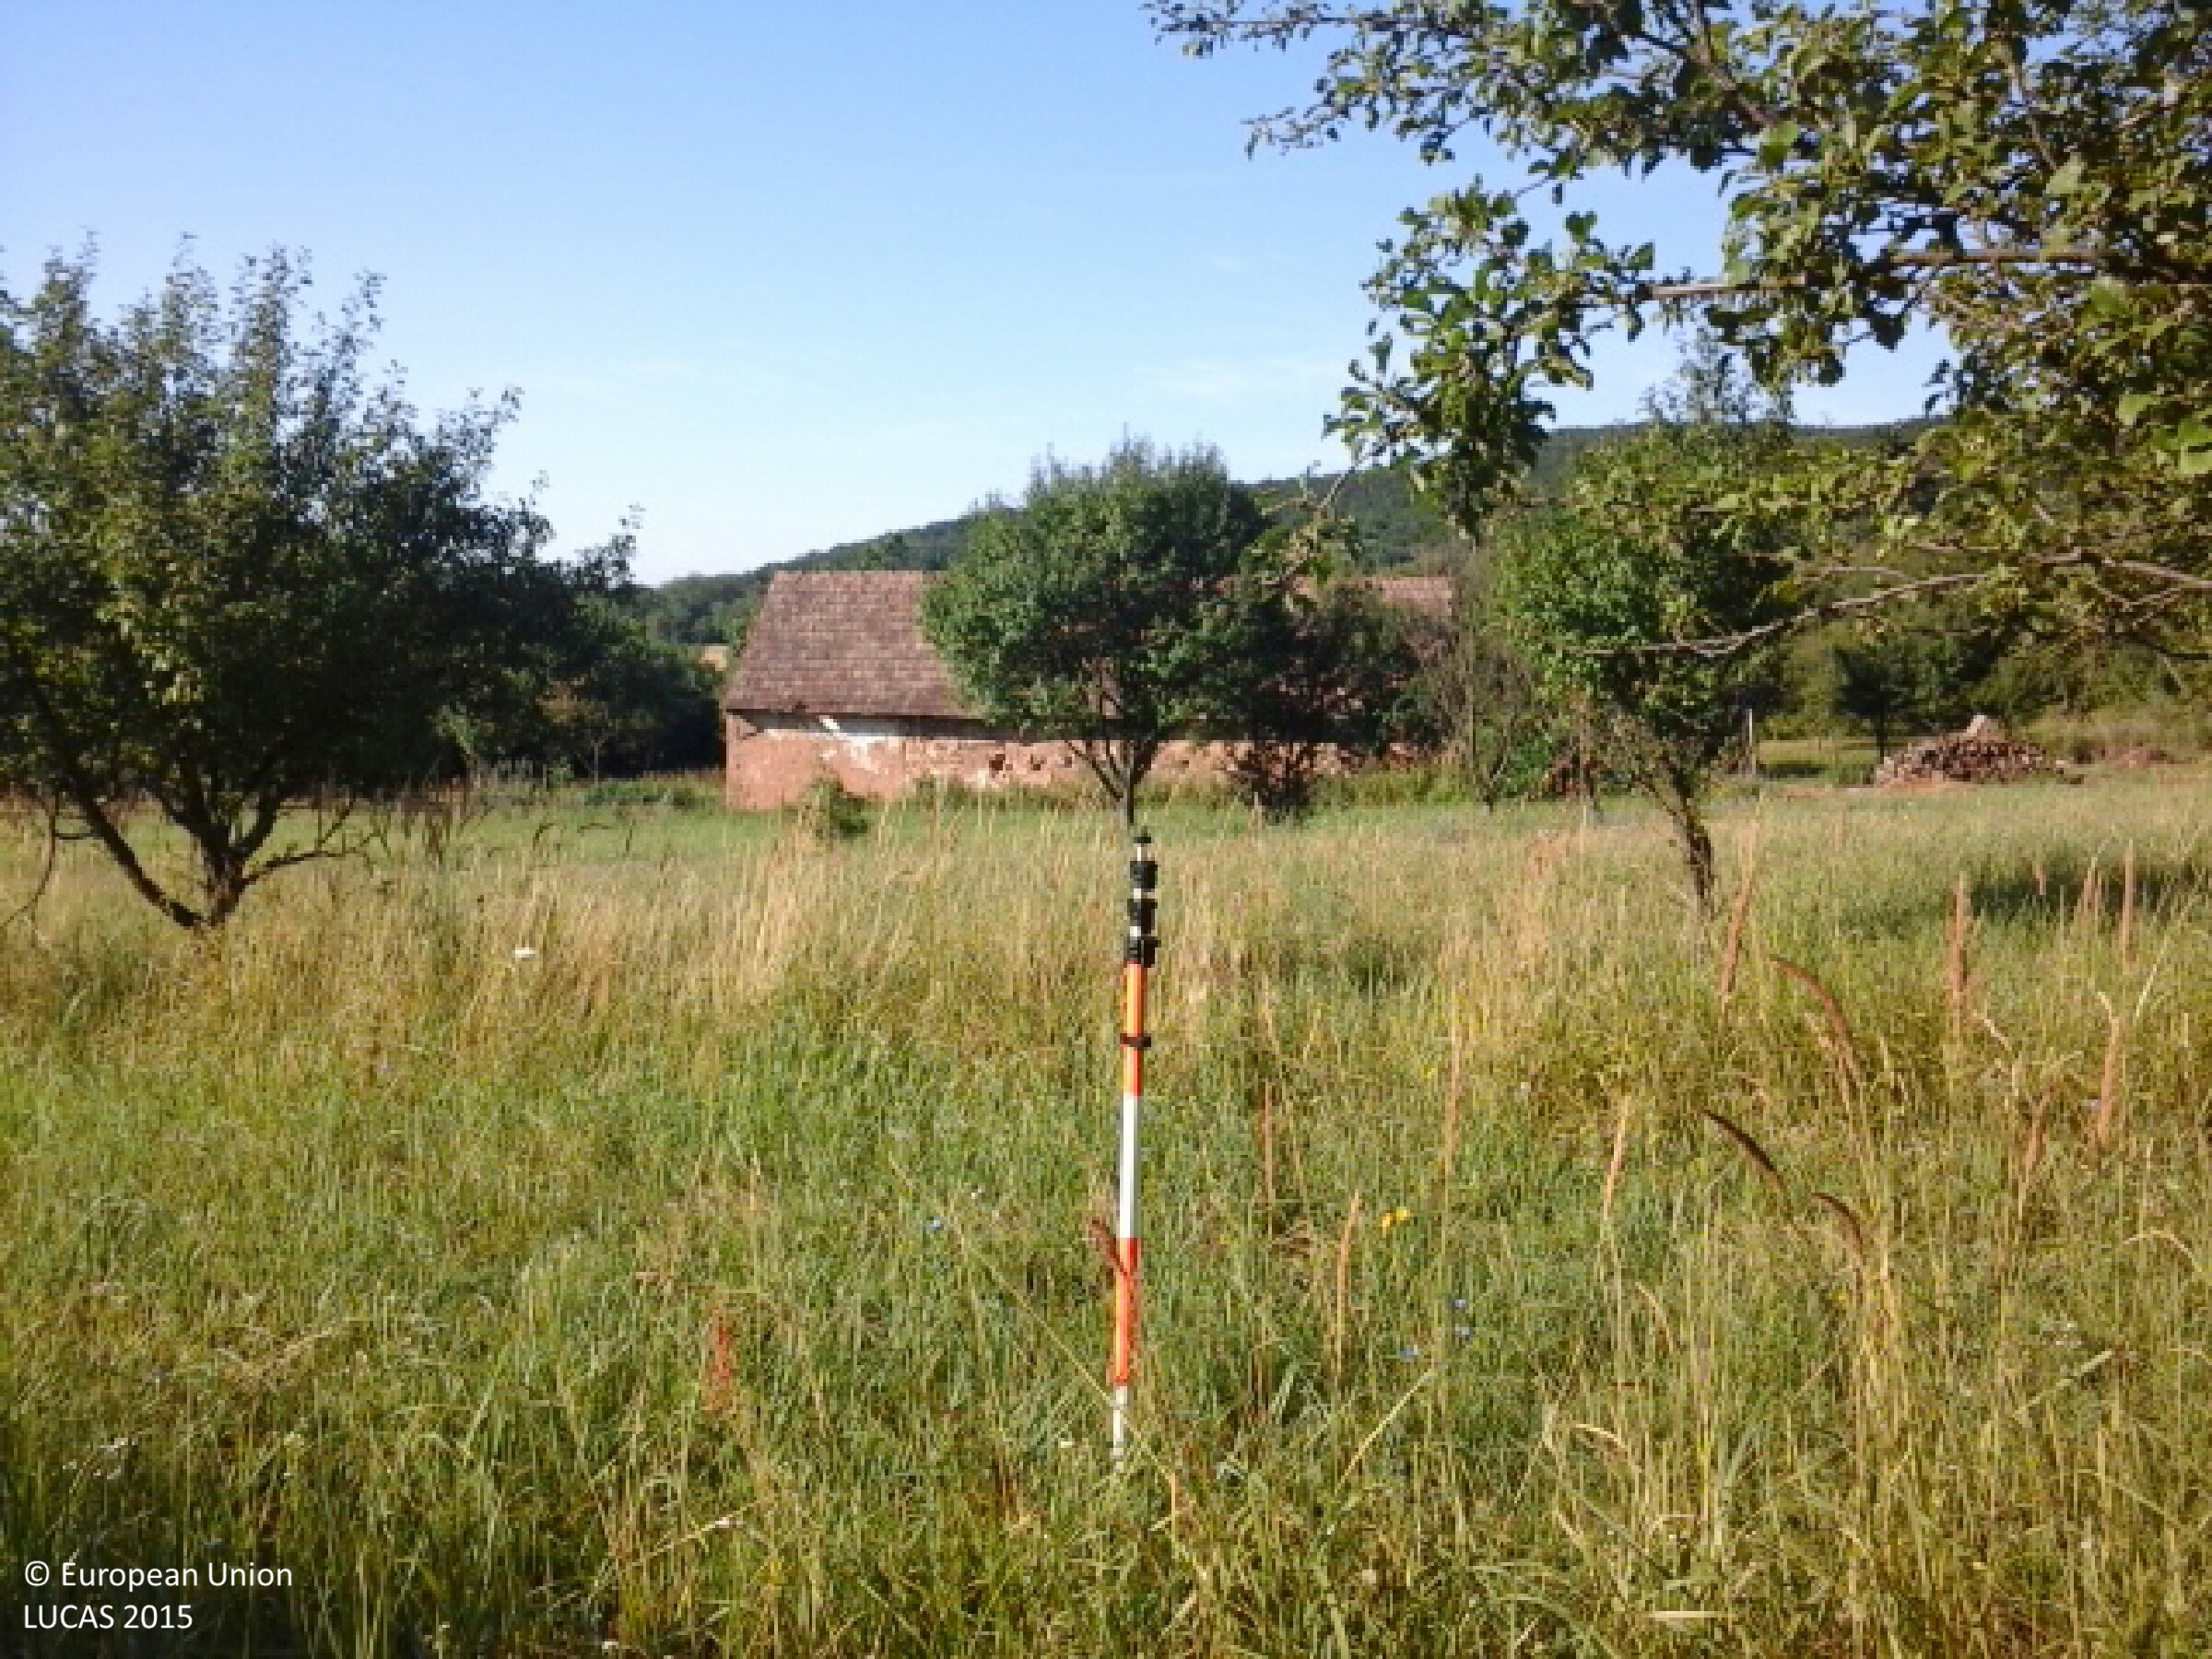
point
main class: Cropland
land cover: Other fruit trees and berries
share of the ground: 10 - 25 %
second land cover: Grassland without tree/shrub cover
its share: > 75 %
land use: Agriculture (excluding fallow land and kitchen gardens)
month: July
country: HU
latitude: 48.3584
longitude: 21.5596
